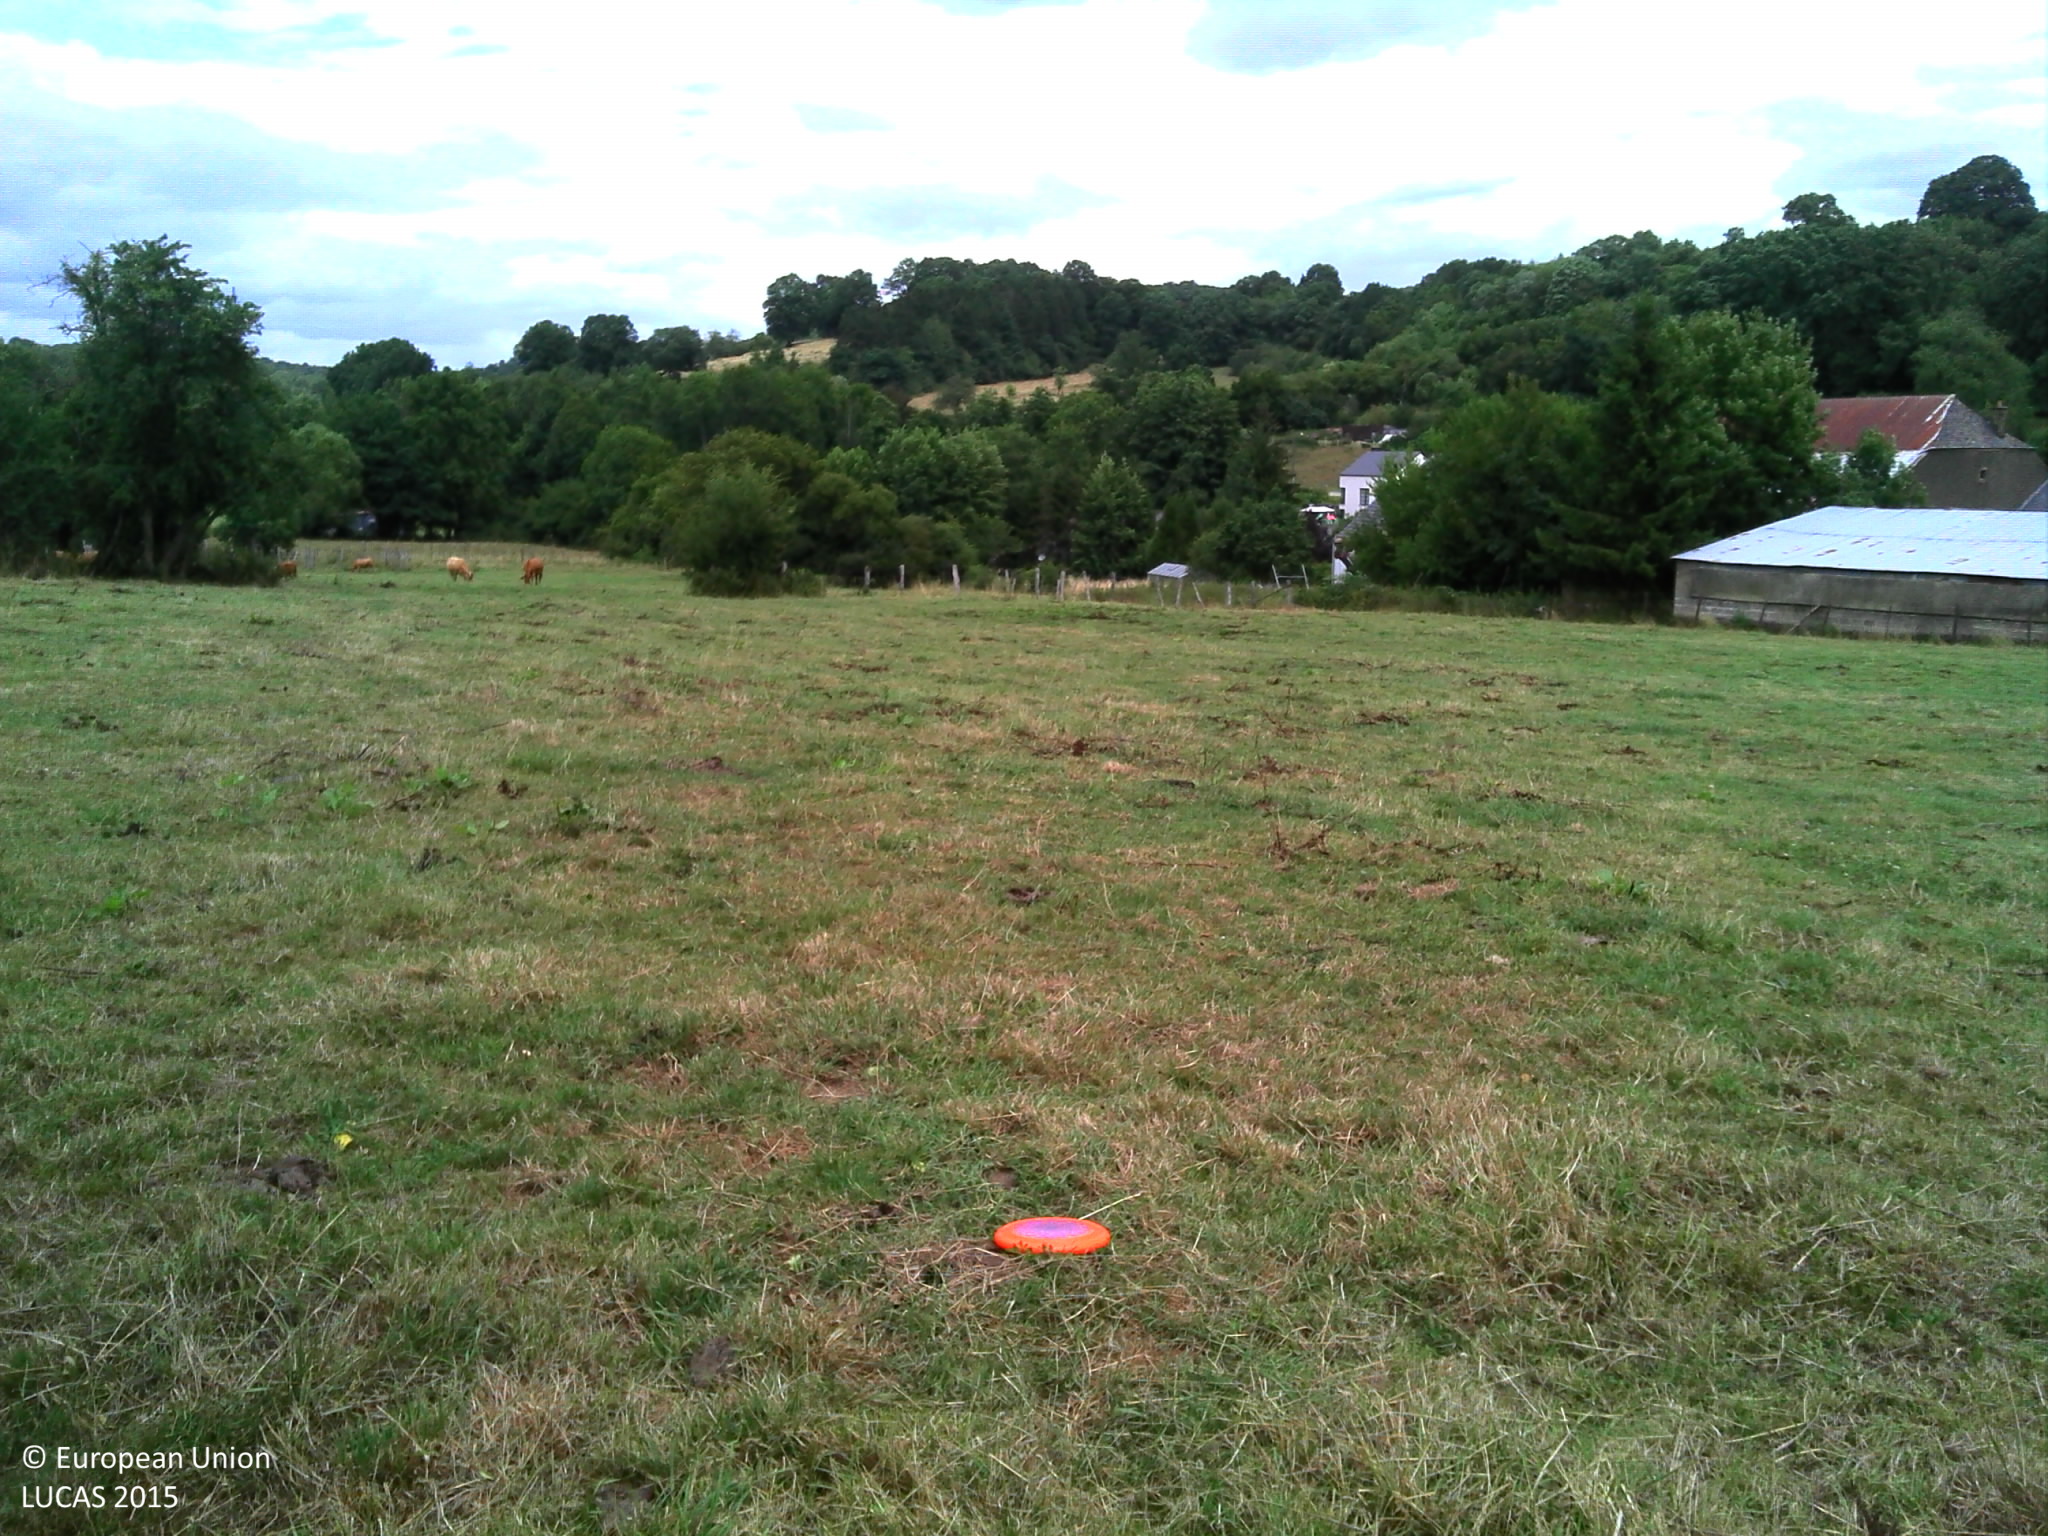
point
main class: Grassland
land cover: Grassland without tree/shrub cover
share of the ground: > 75 %
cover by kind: herbaceous plants 100 %
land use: Agriculture (excluding fallow land and kitchen gardens)
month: July
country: BE
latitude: 49.5808
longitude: 5.6974
